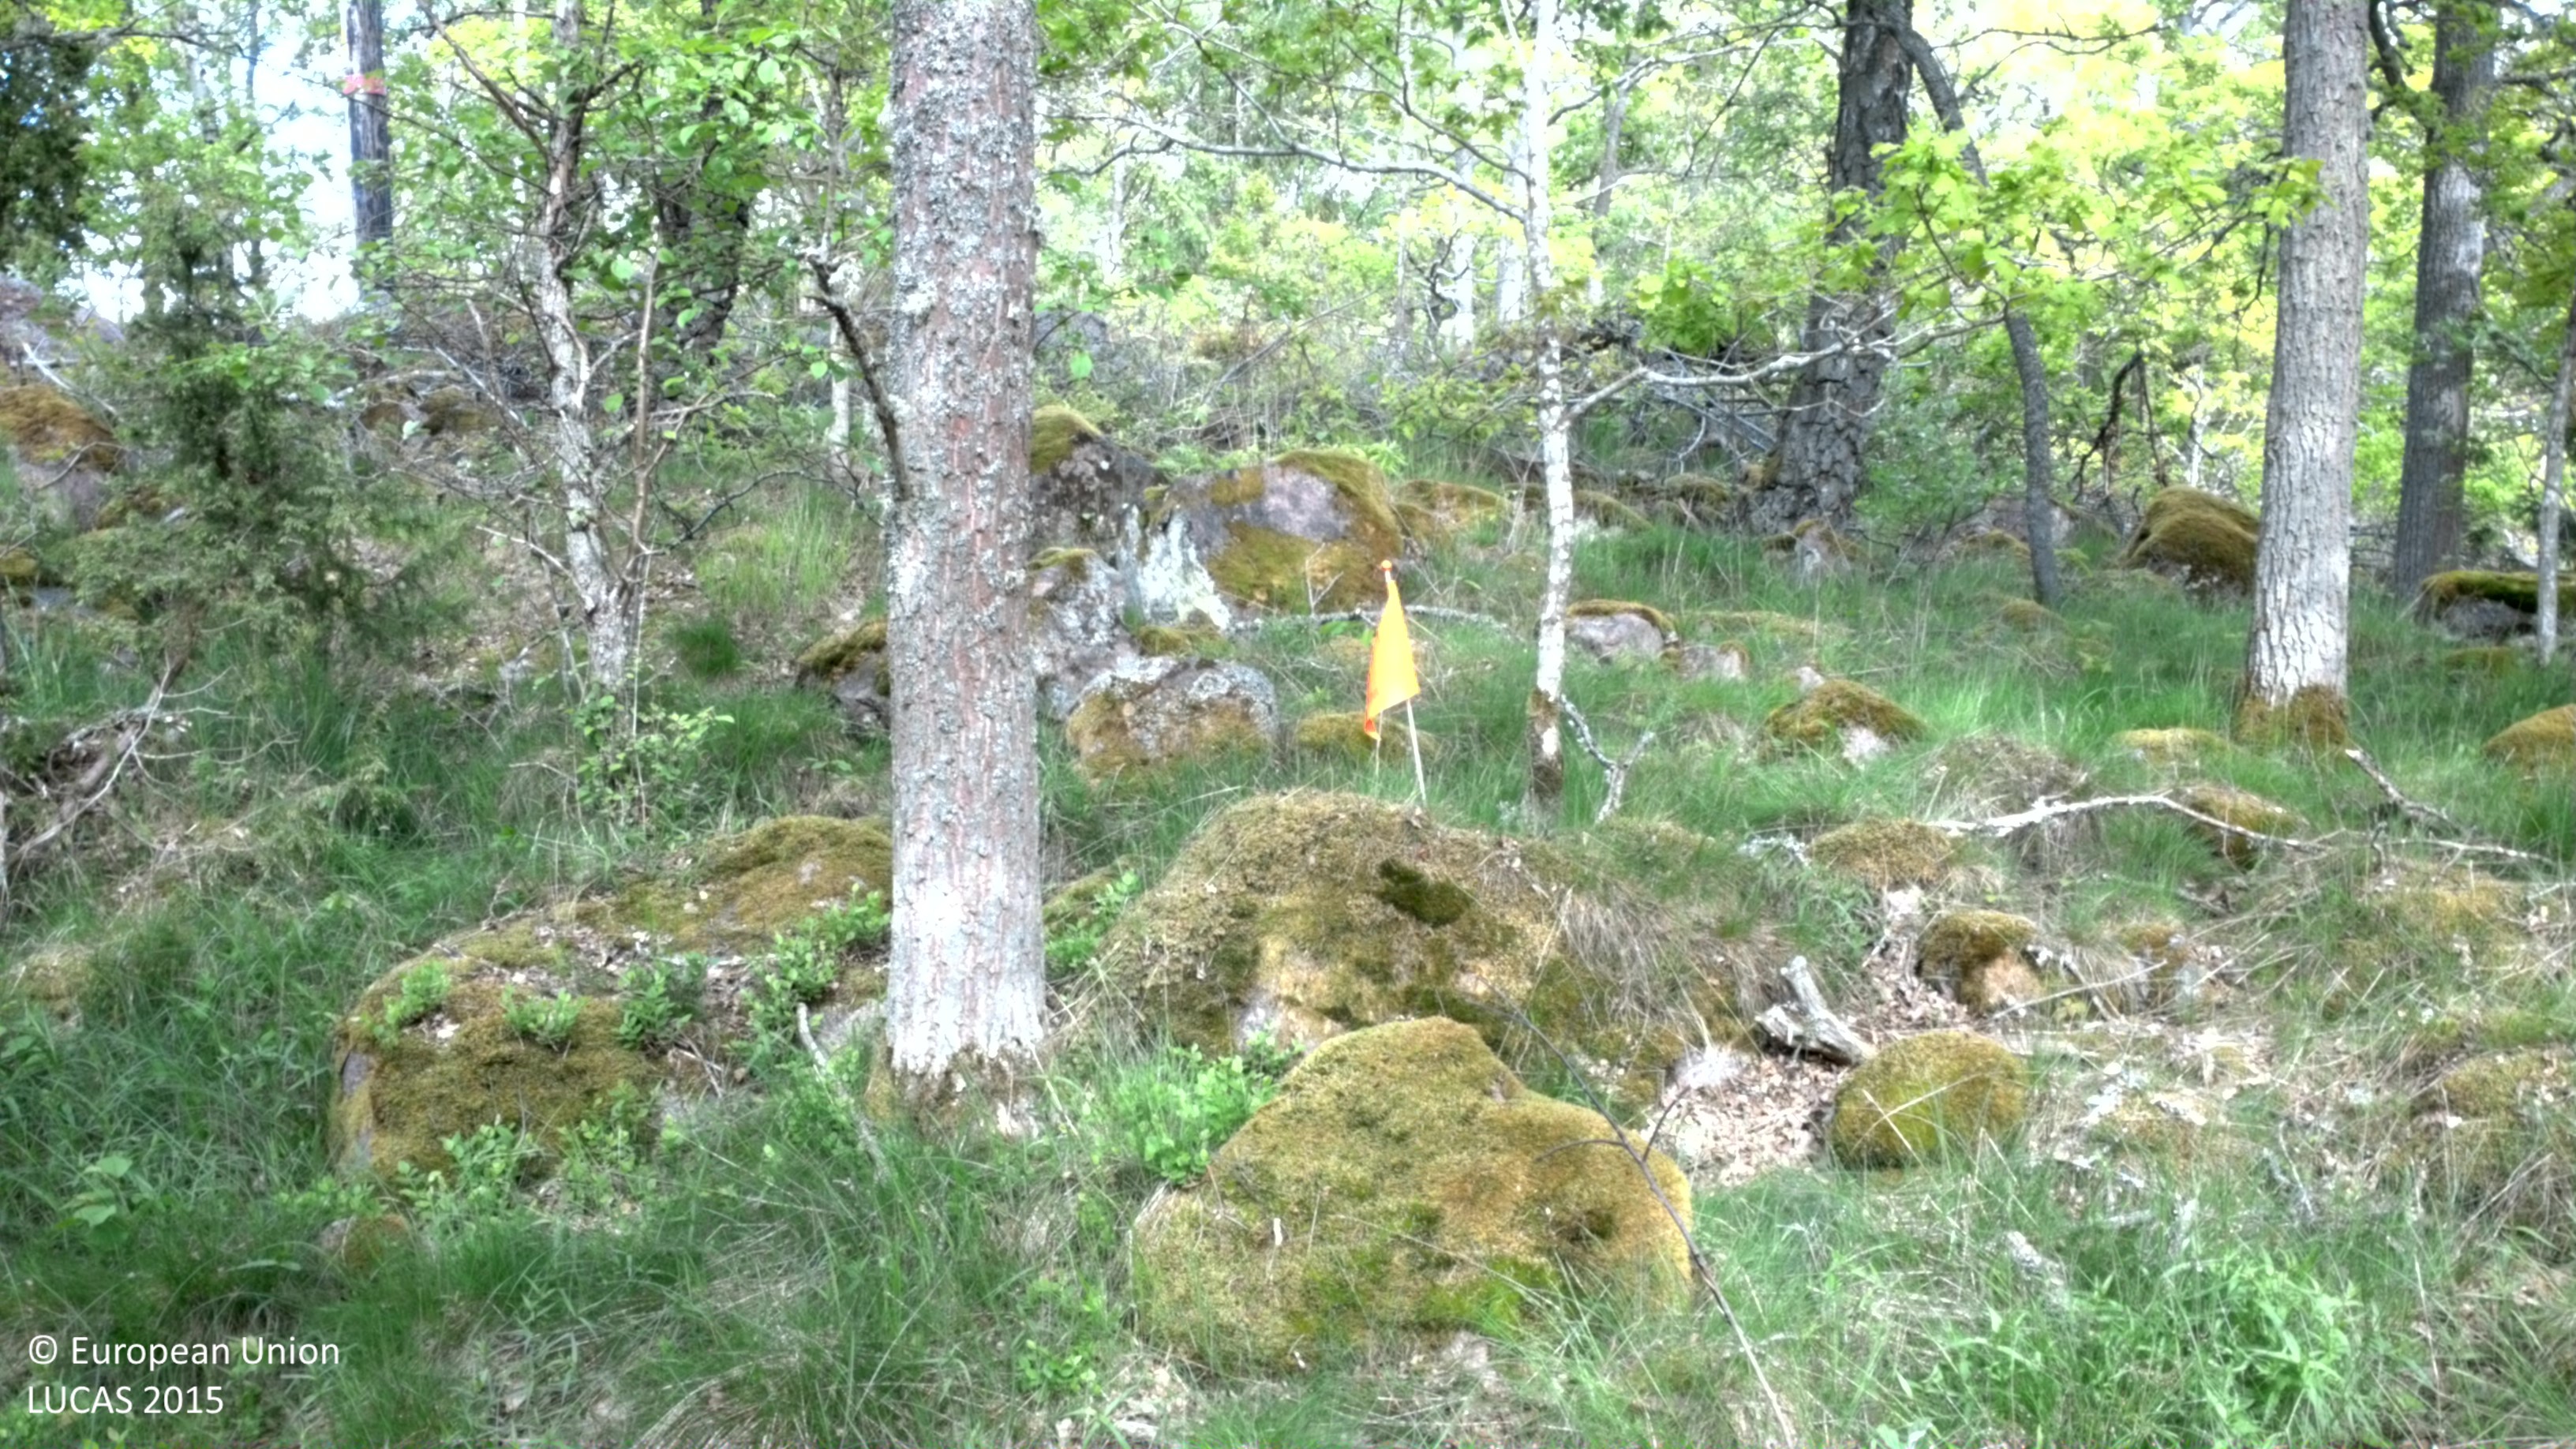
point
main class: Woodland
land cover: Broadleaved woodland
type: mesophytic deciduous forest
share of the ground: > 75 %
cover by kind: broadleaved forest trees 90 %, shrubs 5 %, herbaceous plants 5 %
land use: Forestry
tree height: > 5 m
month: May
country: SE
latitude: 57.1436
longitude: 16.4619
